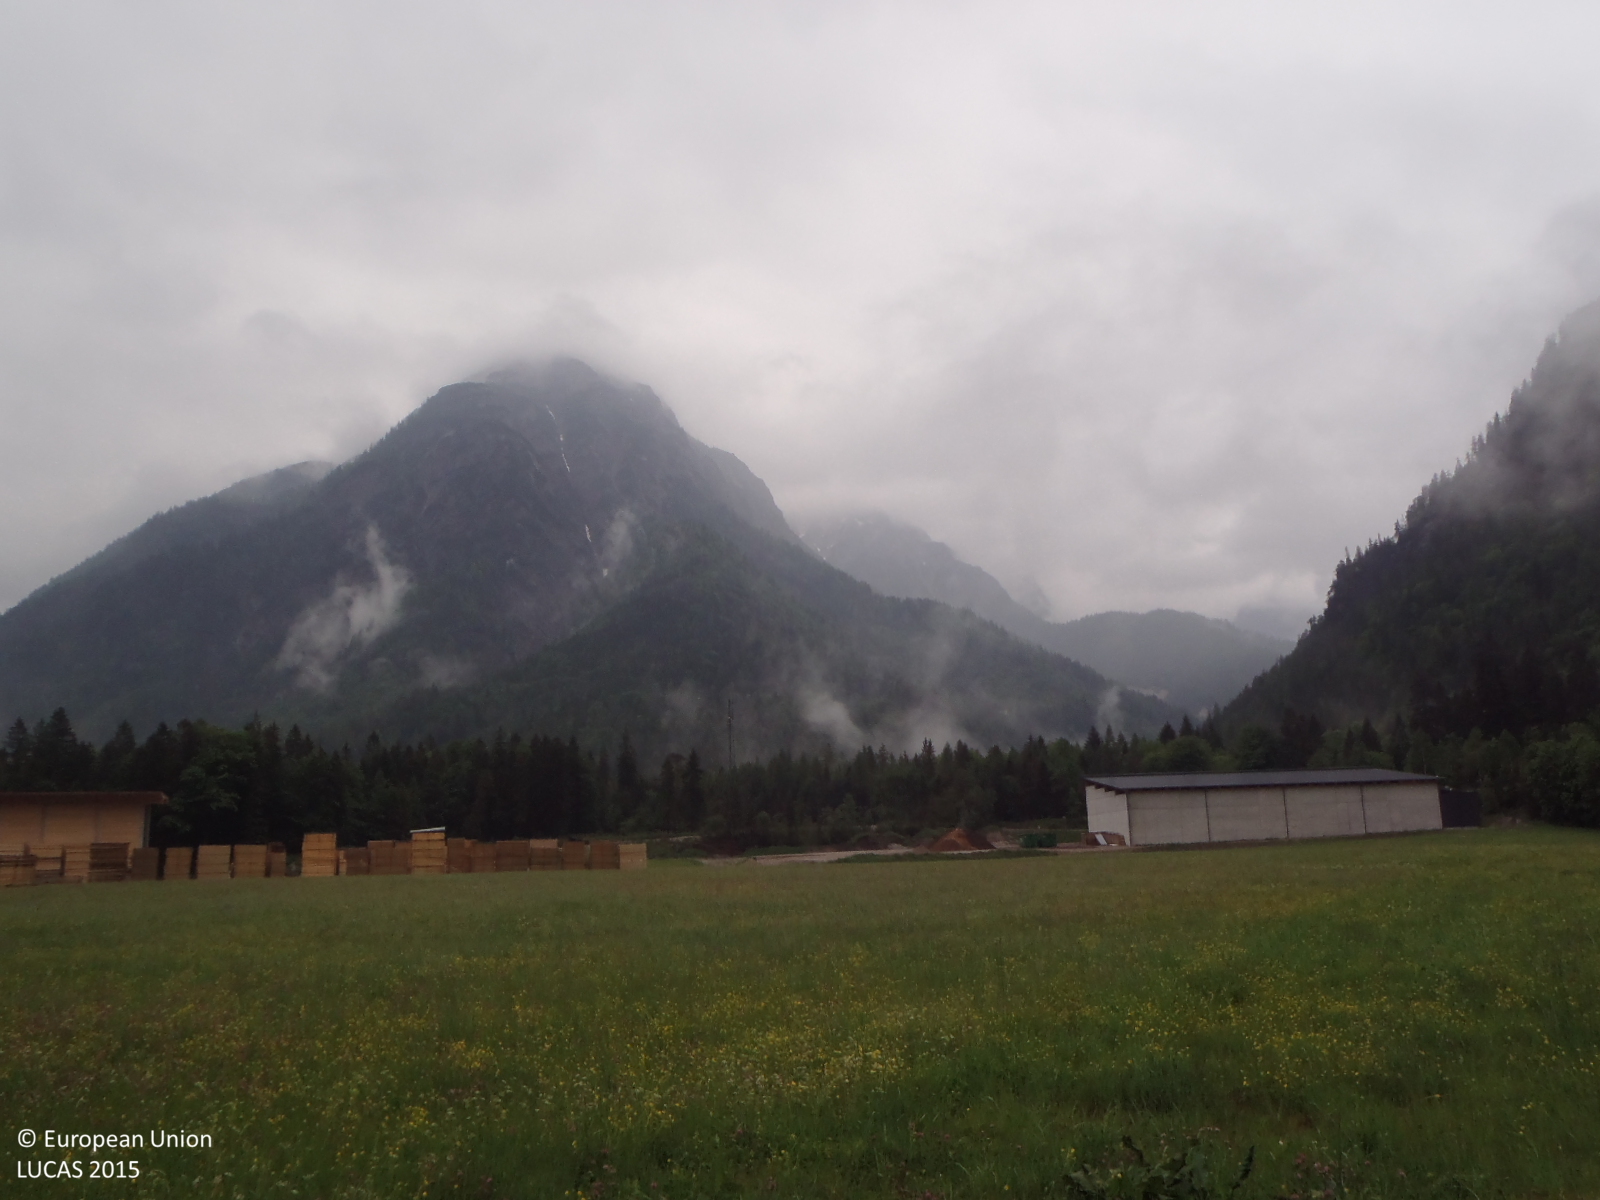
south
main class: Grassland
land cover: Grassland without tree/shrub cover
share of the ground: > 75 %
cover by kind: herbaceous plants 100 %
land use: Agriculture (excluding fallow land and kitchen gardens)
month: May
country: AT
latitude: 47.5417
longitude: 12.7219
